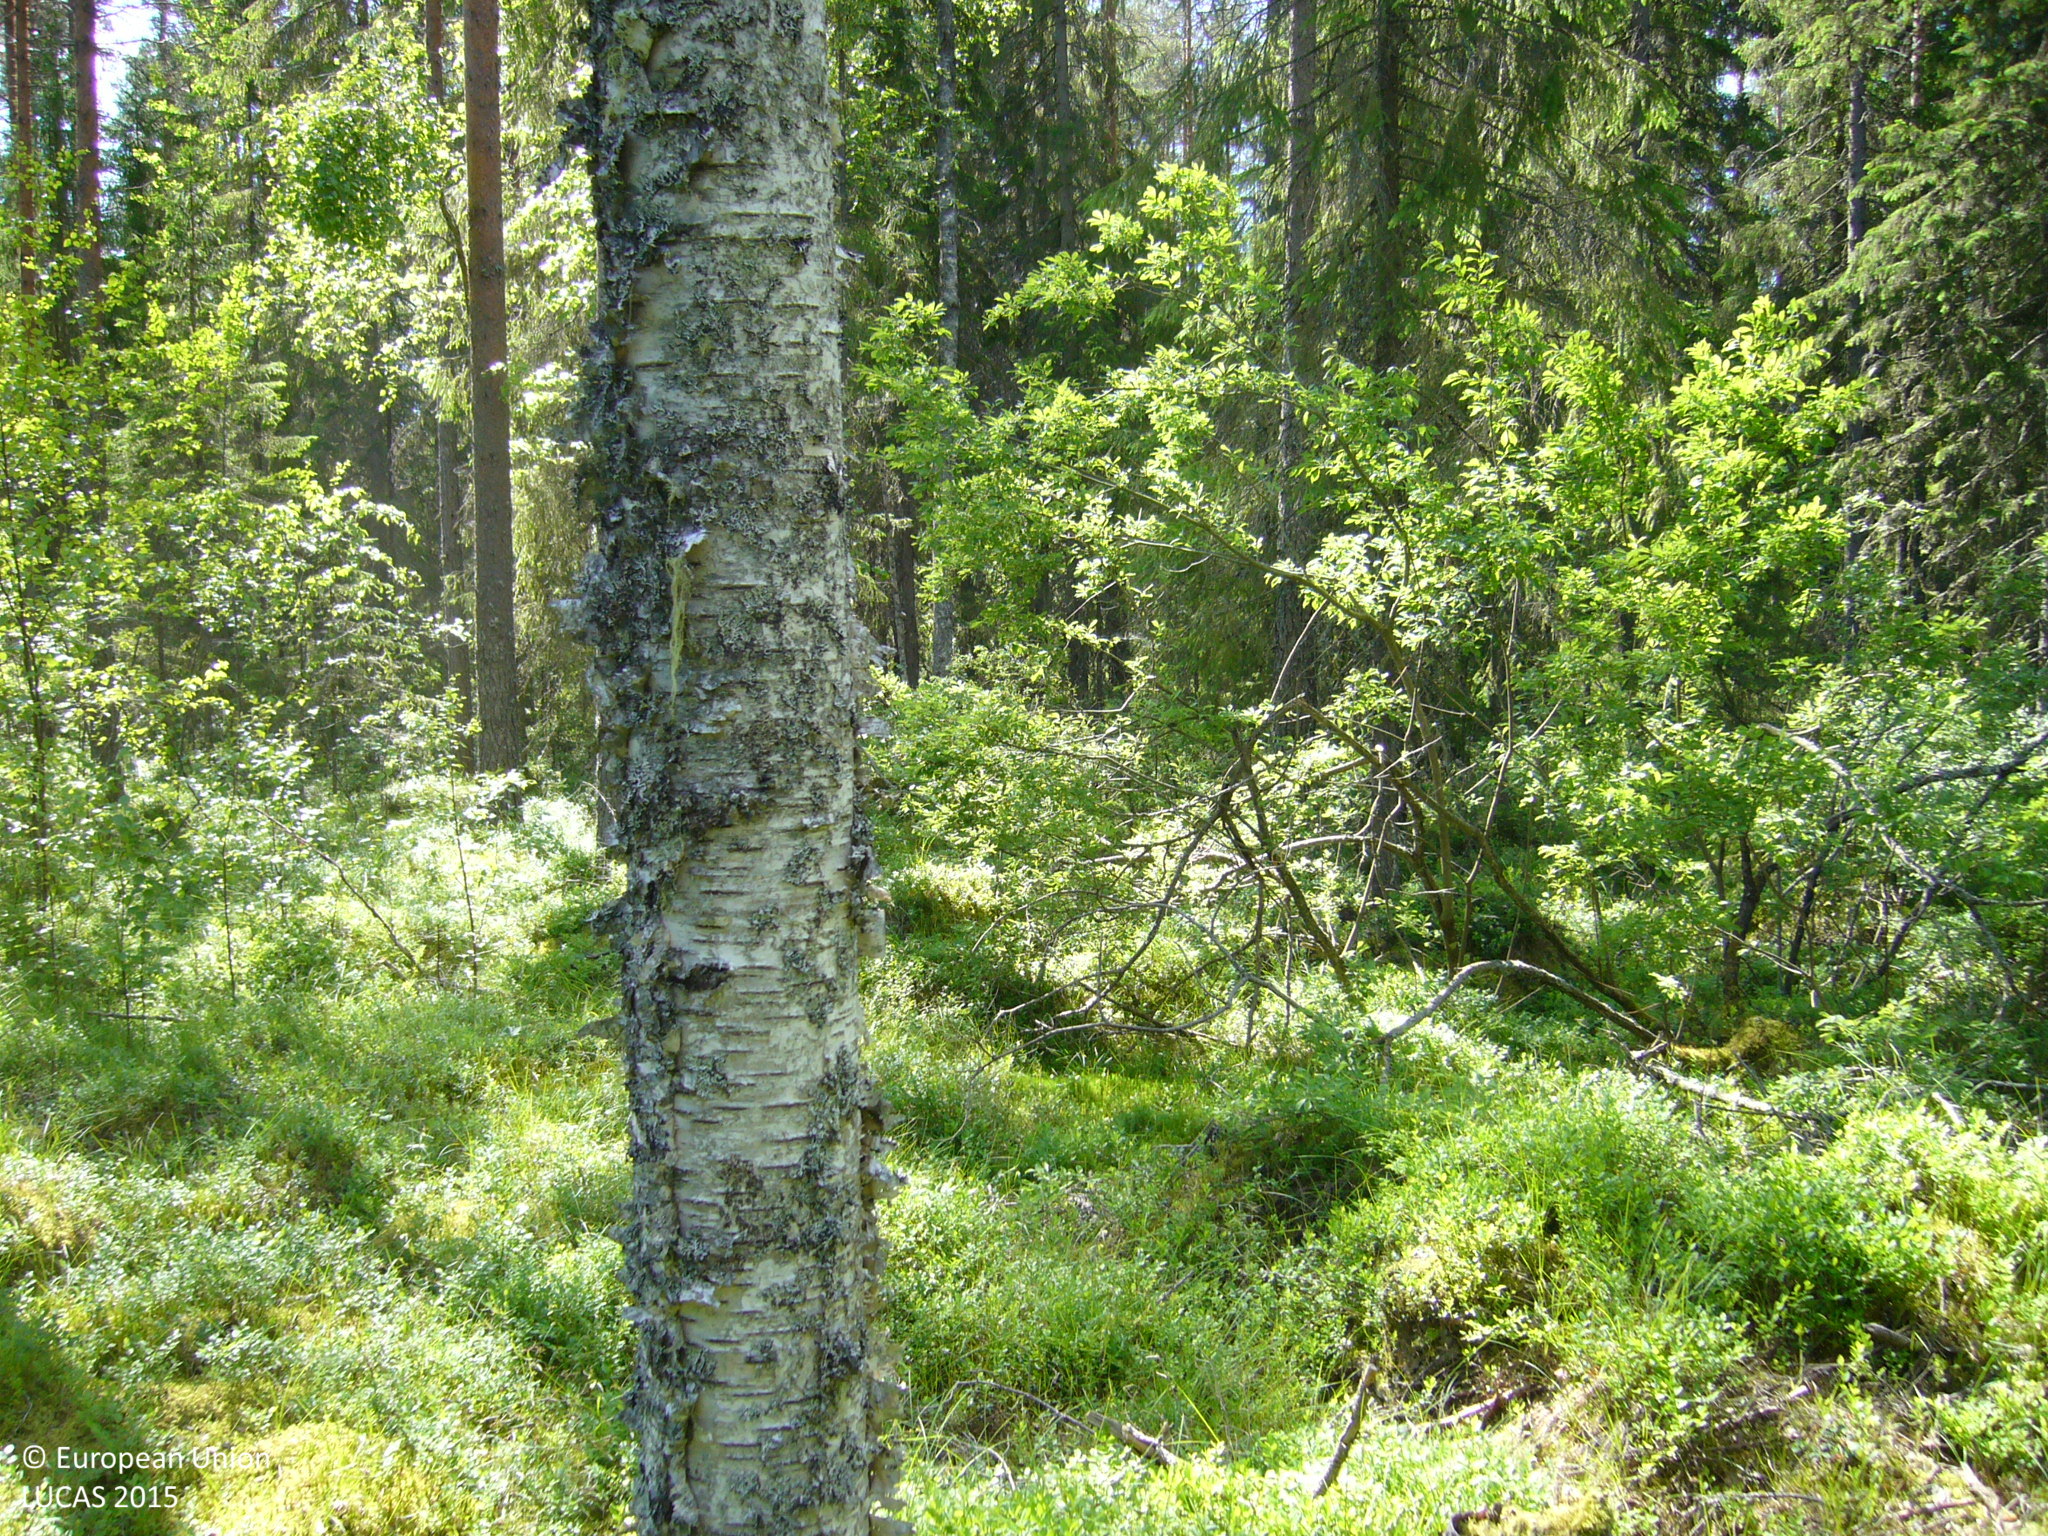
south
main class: Woodland
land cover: Spruce dominated coniferous woodland
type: boreal forest
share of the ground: 50 - 75 %
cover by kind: coniferous forest trees 50 %, shrubs 40 %, broadleaved forest trees 10 %
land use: Forestry
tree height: > 5 m
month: July
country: FI
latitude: 63.3094
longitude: 26.2662
